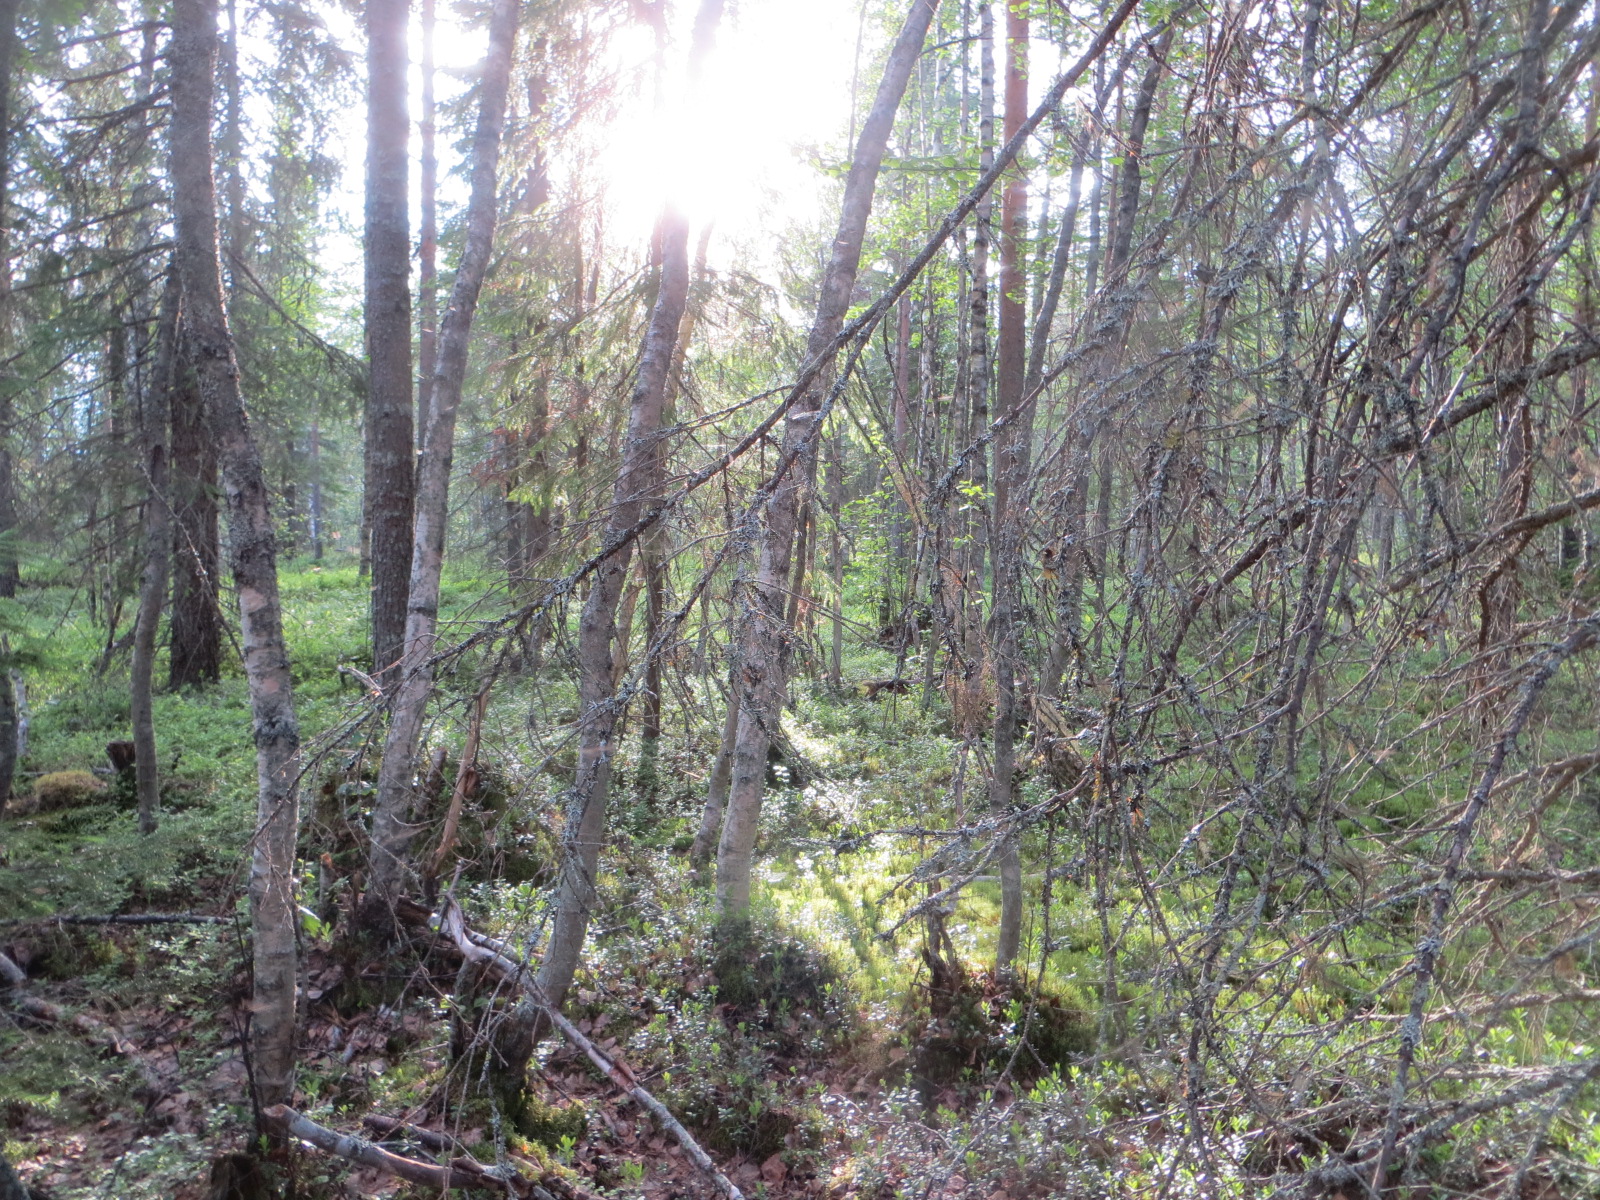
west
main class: Woodland
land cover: Pine dominated mixed woodland
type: boreal forest
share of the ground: 50 - 75 %
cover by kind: shrubs 40 %, coniferous forest trees 35 %, broadleaved forest trees 25 %
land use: Forestry
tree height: > 5 m
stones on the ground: 25 - 50 %
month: July
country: FI
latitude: 65.6301
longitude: 26.0521
